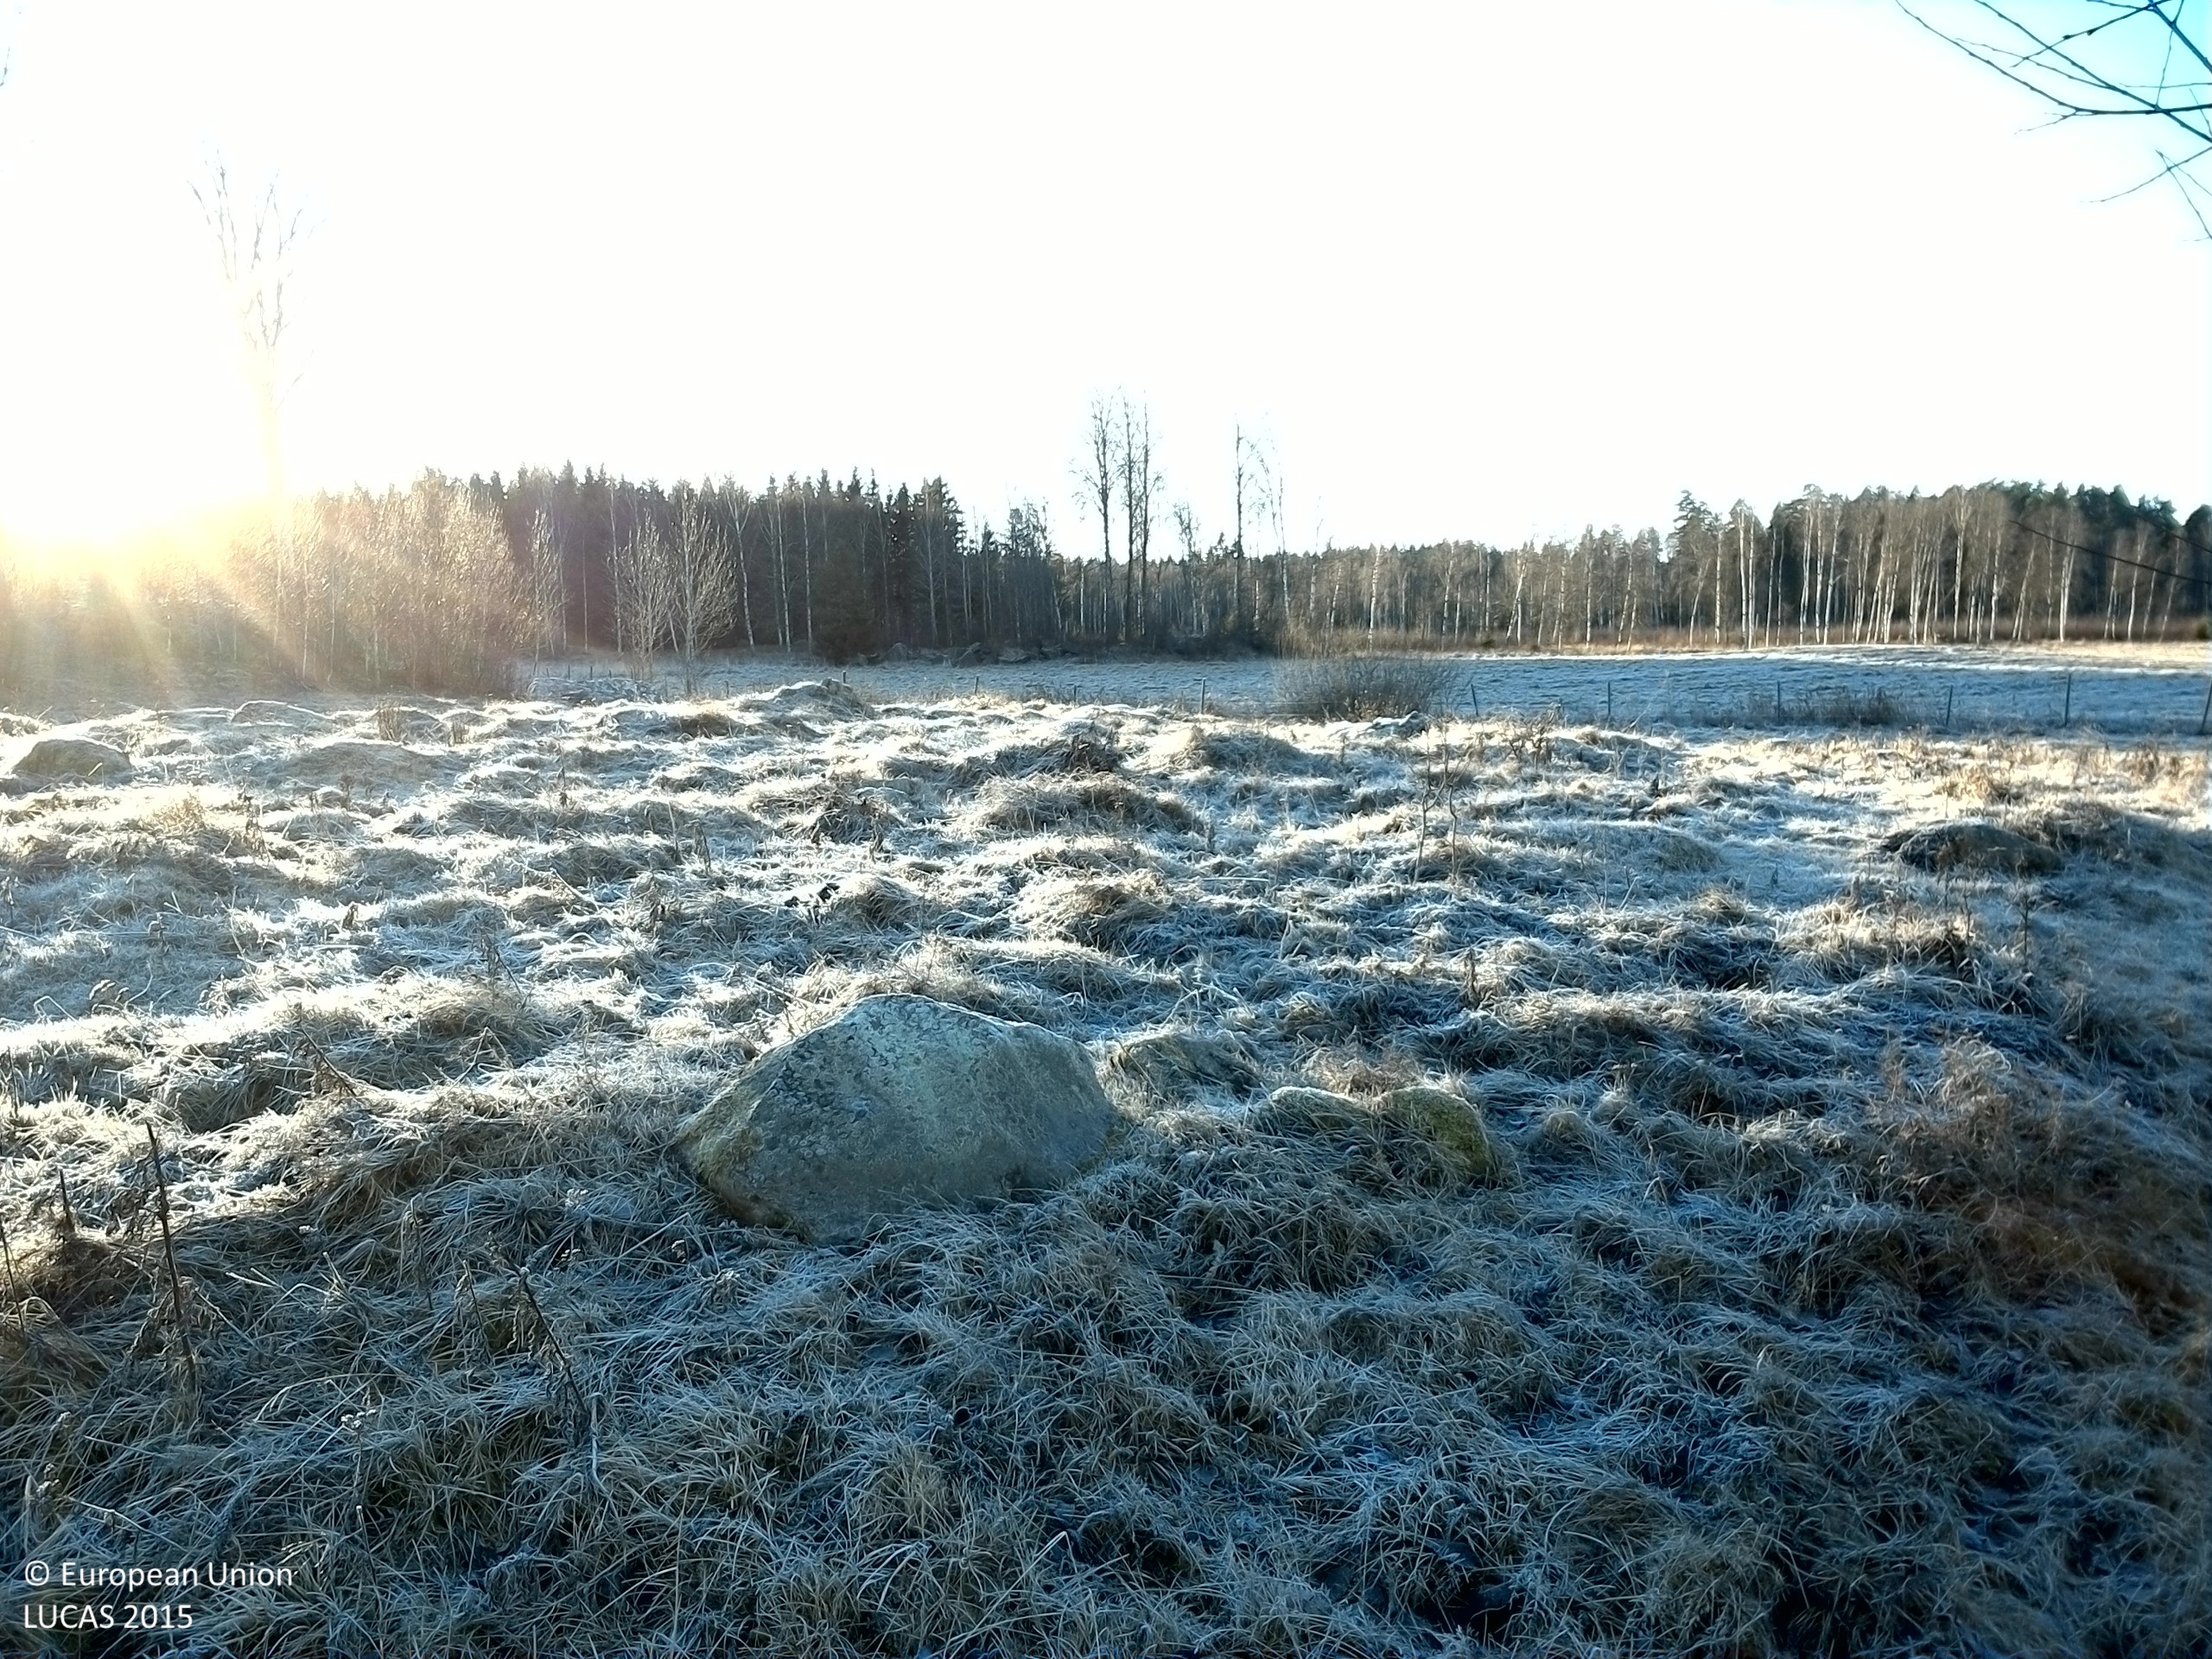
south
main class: Grassland
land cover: Grassland with sparse tree/shrub cover
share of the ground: > 75 %
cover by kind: herbaceous plants 95 %, broadleaved forest trees 5 %
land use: Fallow land
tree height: < 5 m
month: December
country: SE
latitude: 59.3517
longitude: 16.3417
